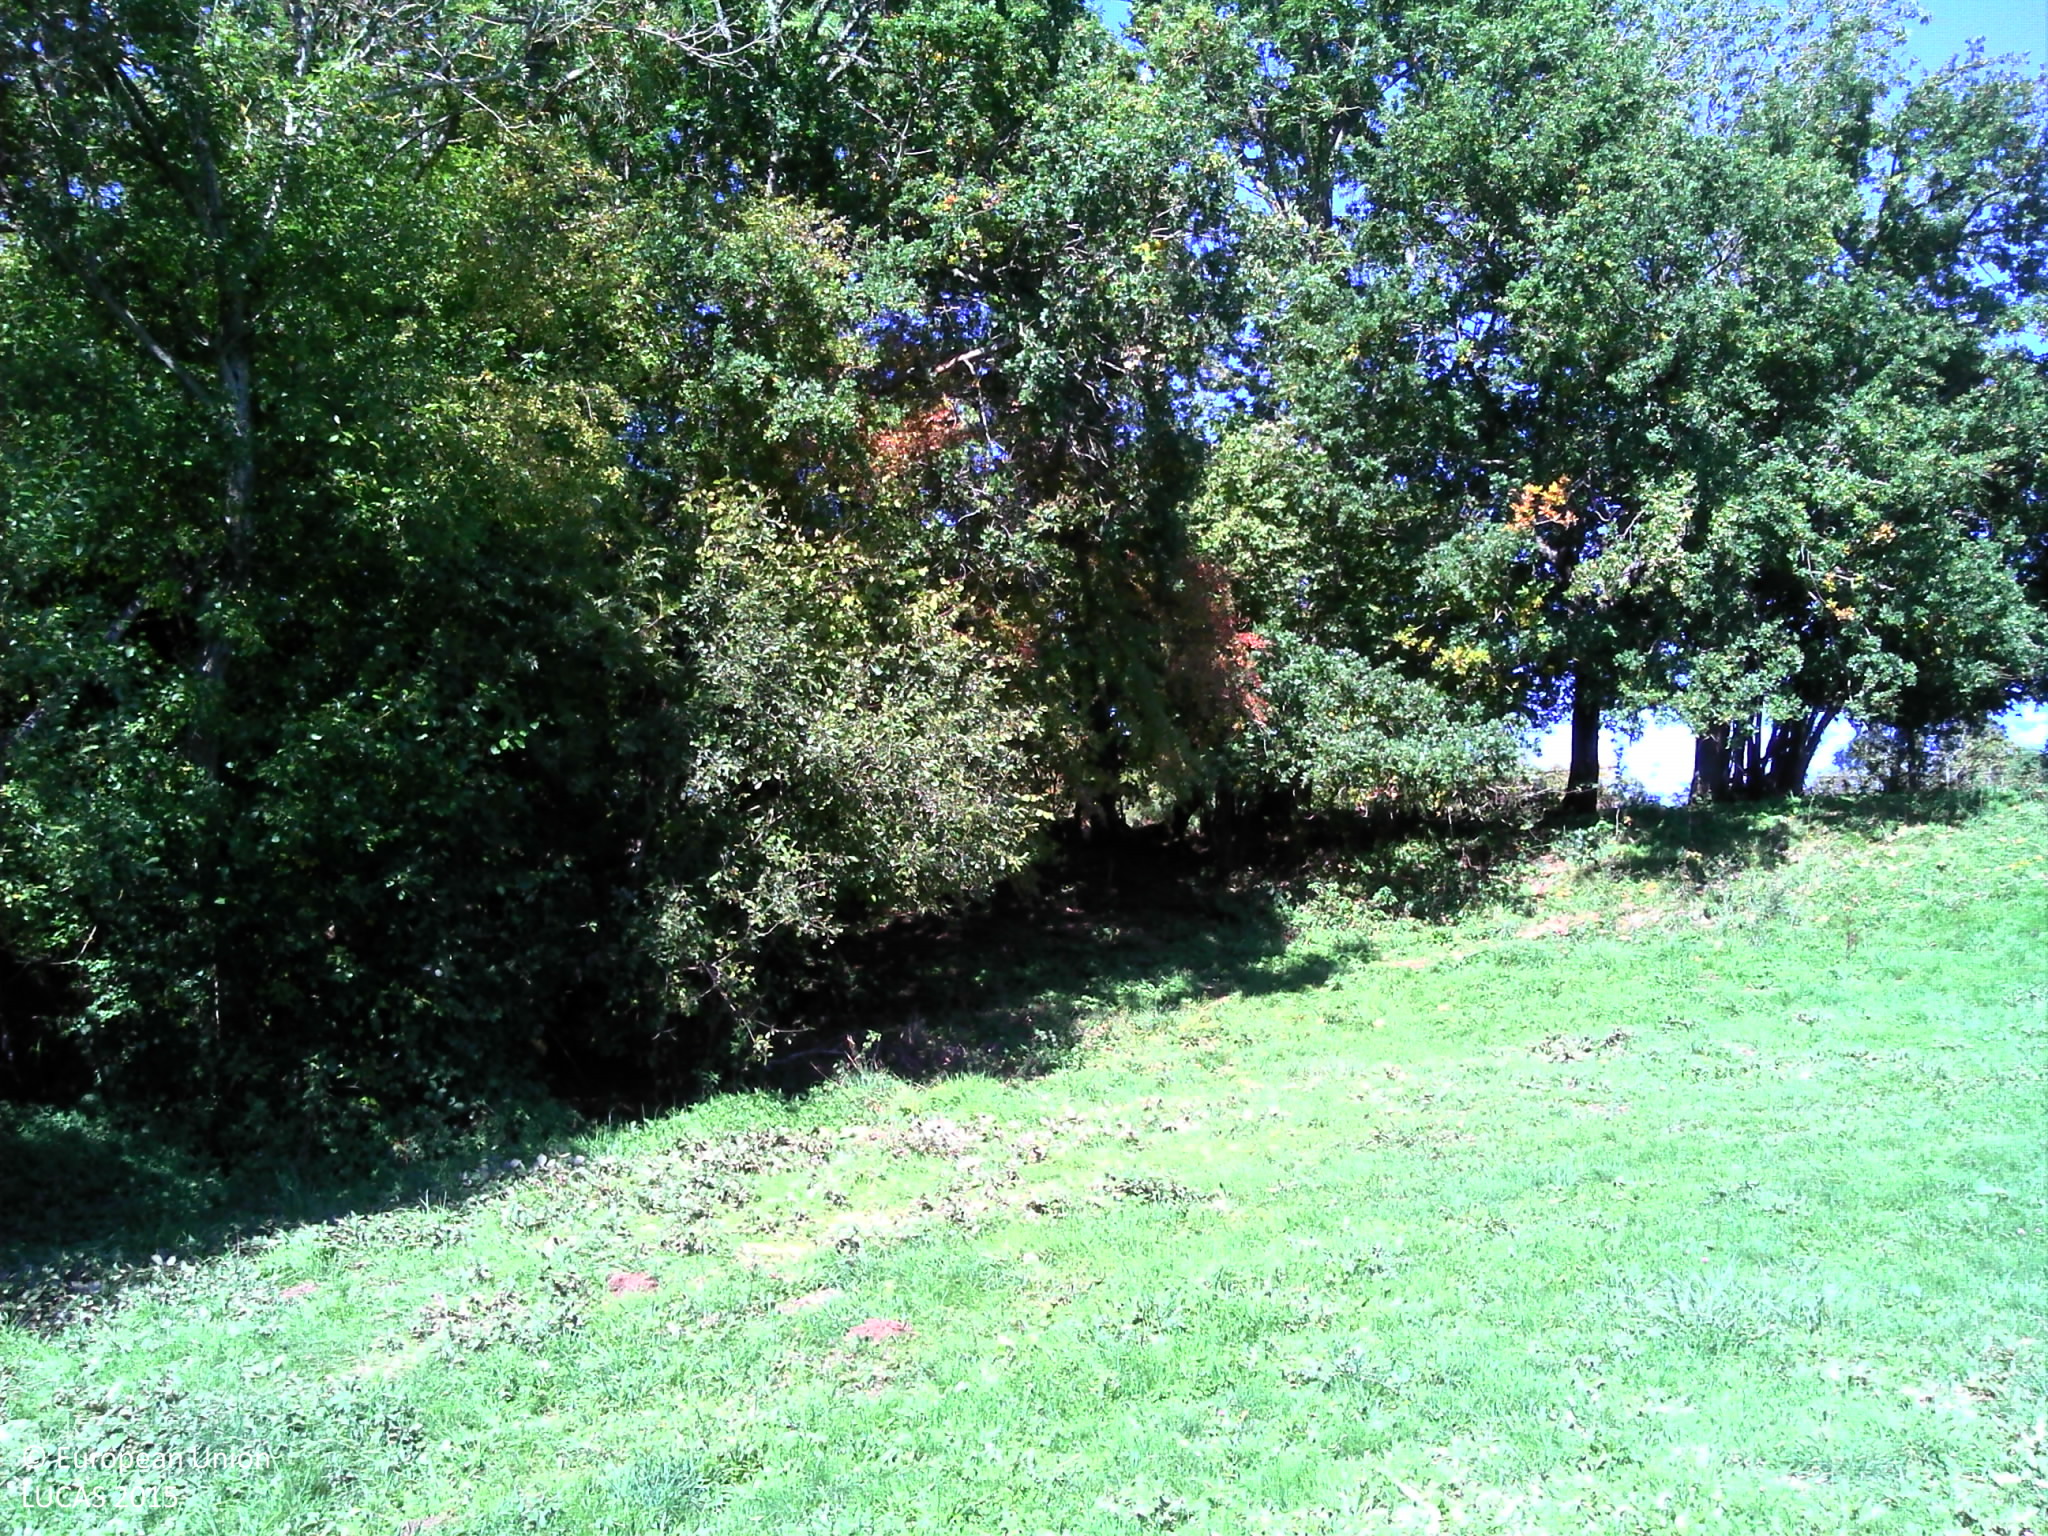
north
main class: Grassland
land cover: Grassland without tree/shrub cover
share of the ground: > 75 %
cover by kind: herbaceous plants 100 %
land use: Agriculture (excluding fallow land and kitchen gardens)
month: September
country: FR
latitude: 45.8211
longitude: 2.8295
